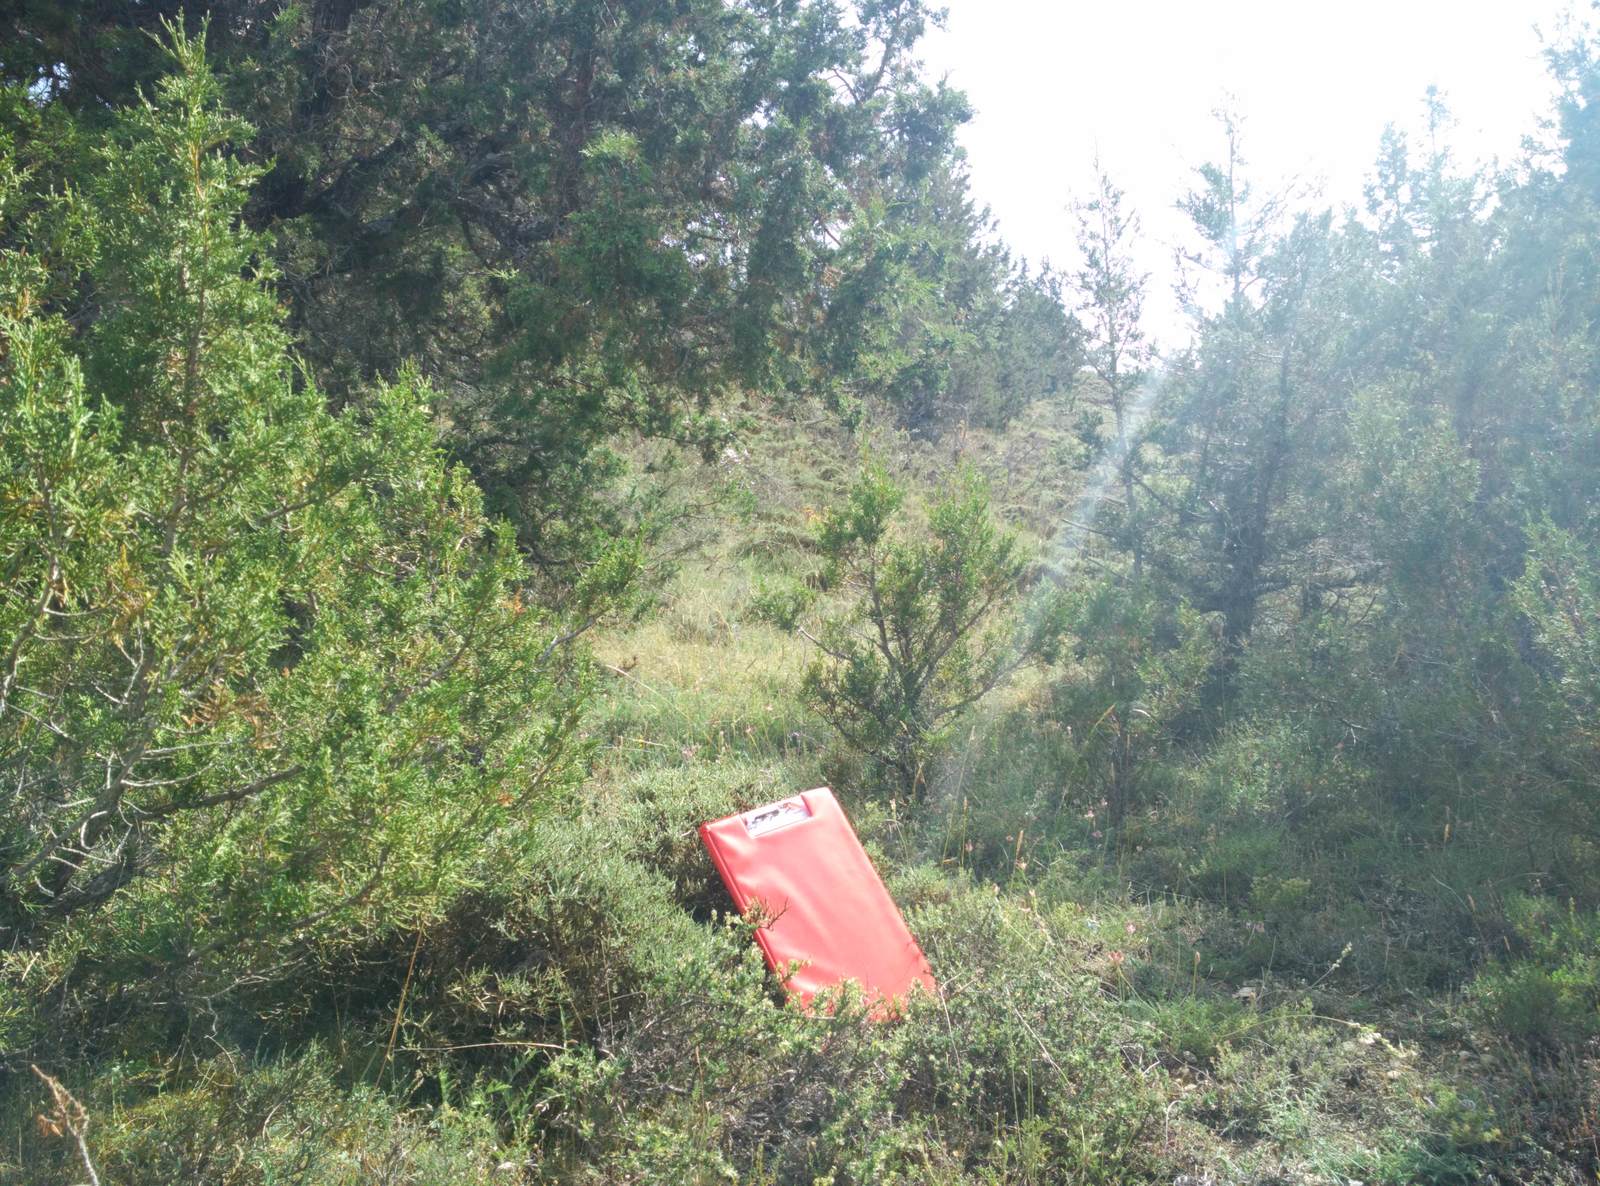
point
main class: Woodland
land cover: Other coniferous woodland
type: coniferous forest of the mediterranean region
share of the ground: 50 - 75 %
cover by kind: coniferous forest trees 50 %, herbaceous plants 25 %, shrubs 20 %, unconsolidated bare surface 5 %
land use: Semi-natural and natural areas not in use
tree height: > 5 m
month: July
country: ES
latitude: 41.0346
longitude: -2.0754
